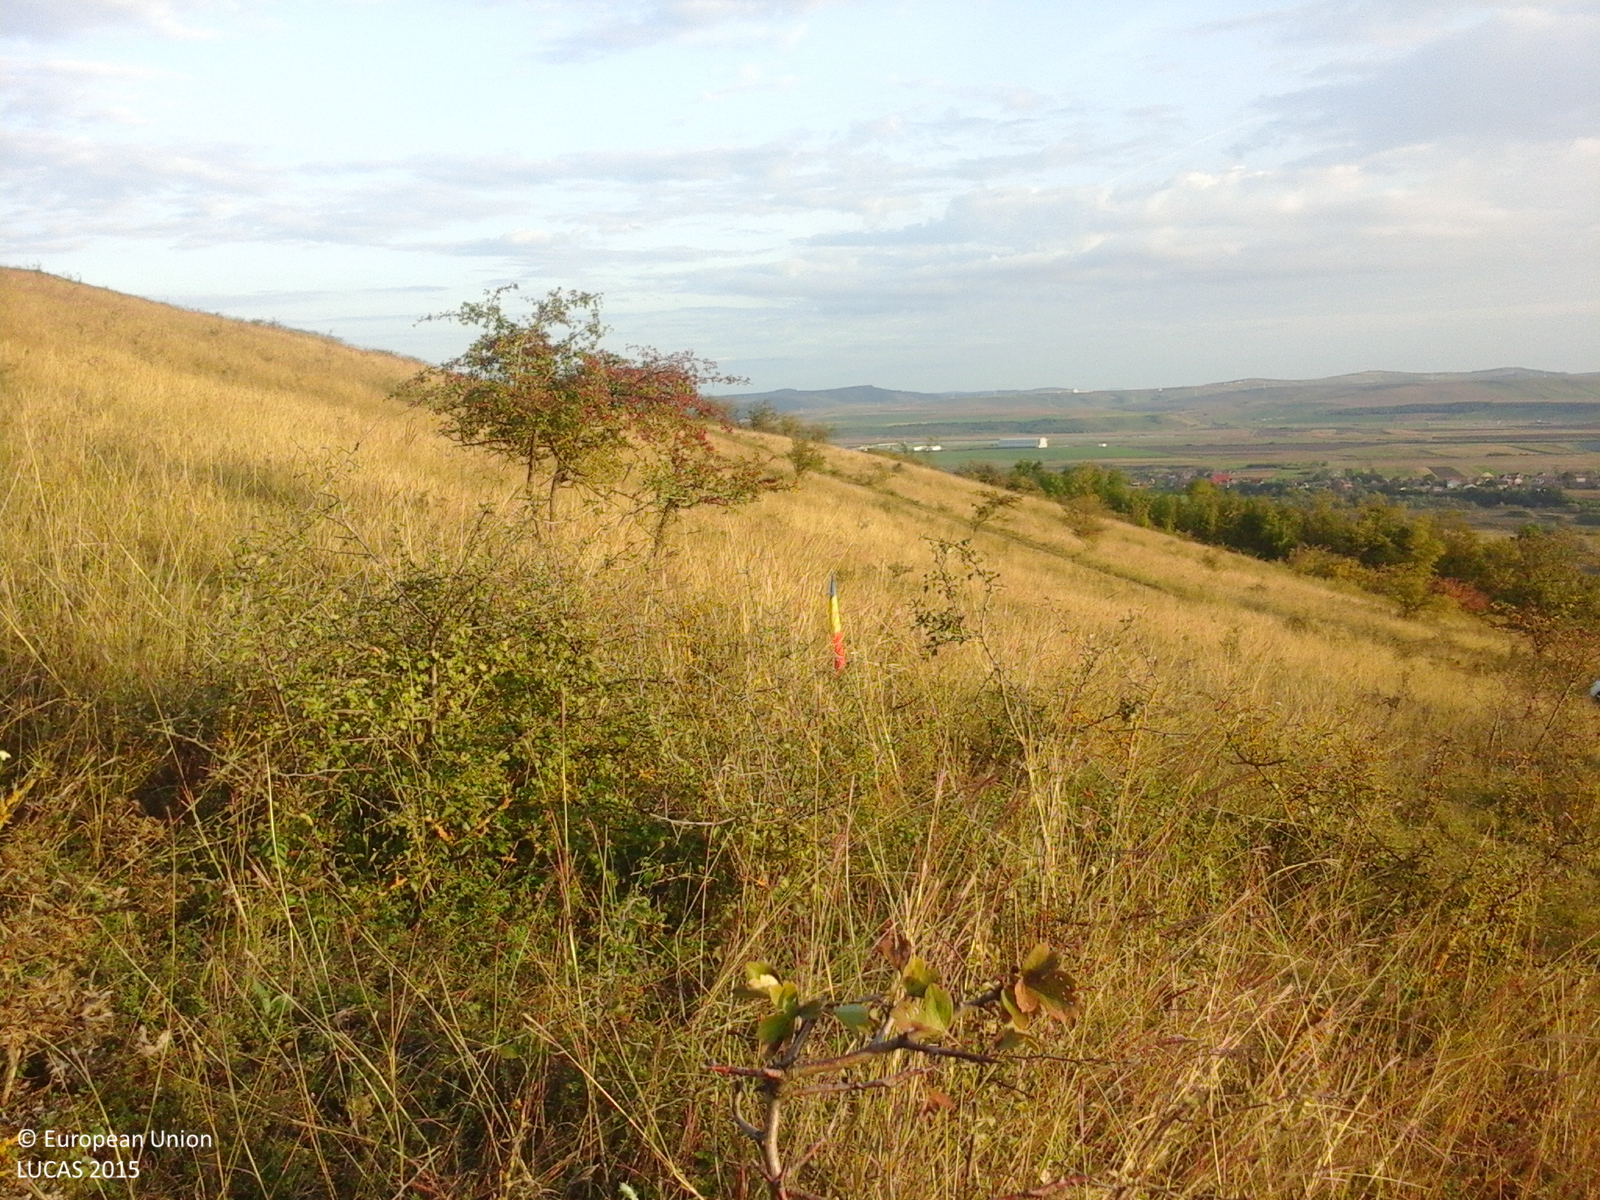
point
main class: Grassland
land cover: Spontaneously vegetated surfaces
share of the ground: > 75 %
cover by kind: herbaceous plants 100 %
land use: Agriculture (excluding fallow land and kitchen gardens)
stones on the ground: < 10 %
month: October
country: RO
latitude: 46.4892
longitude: 24.3755
